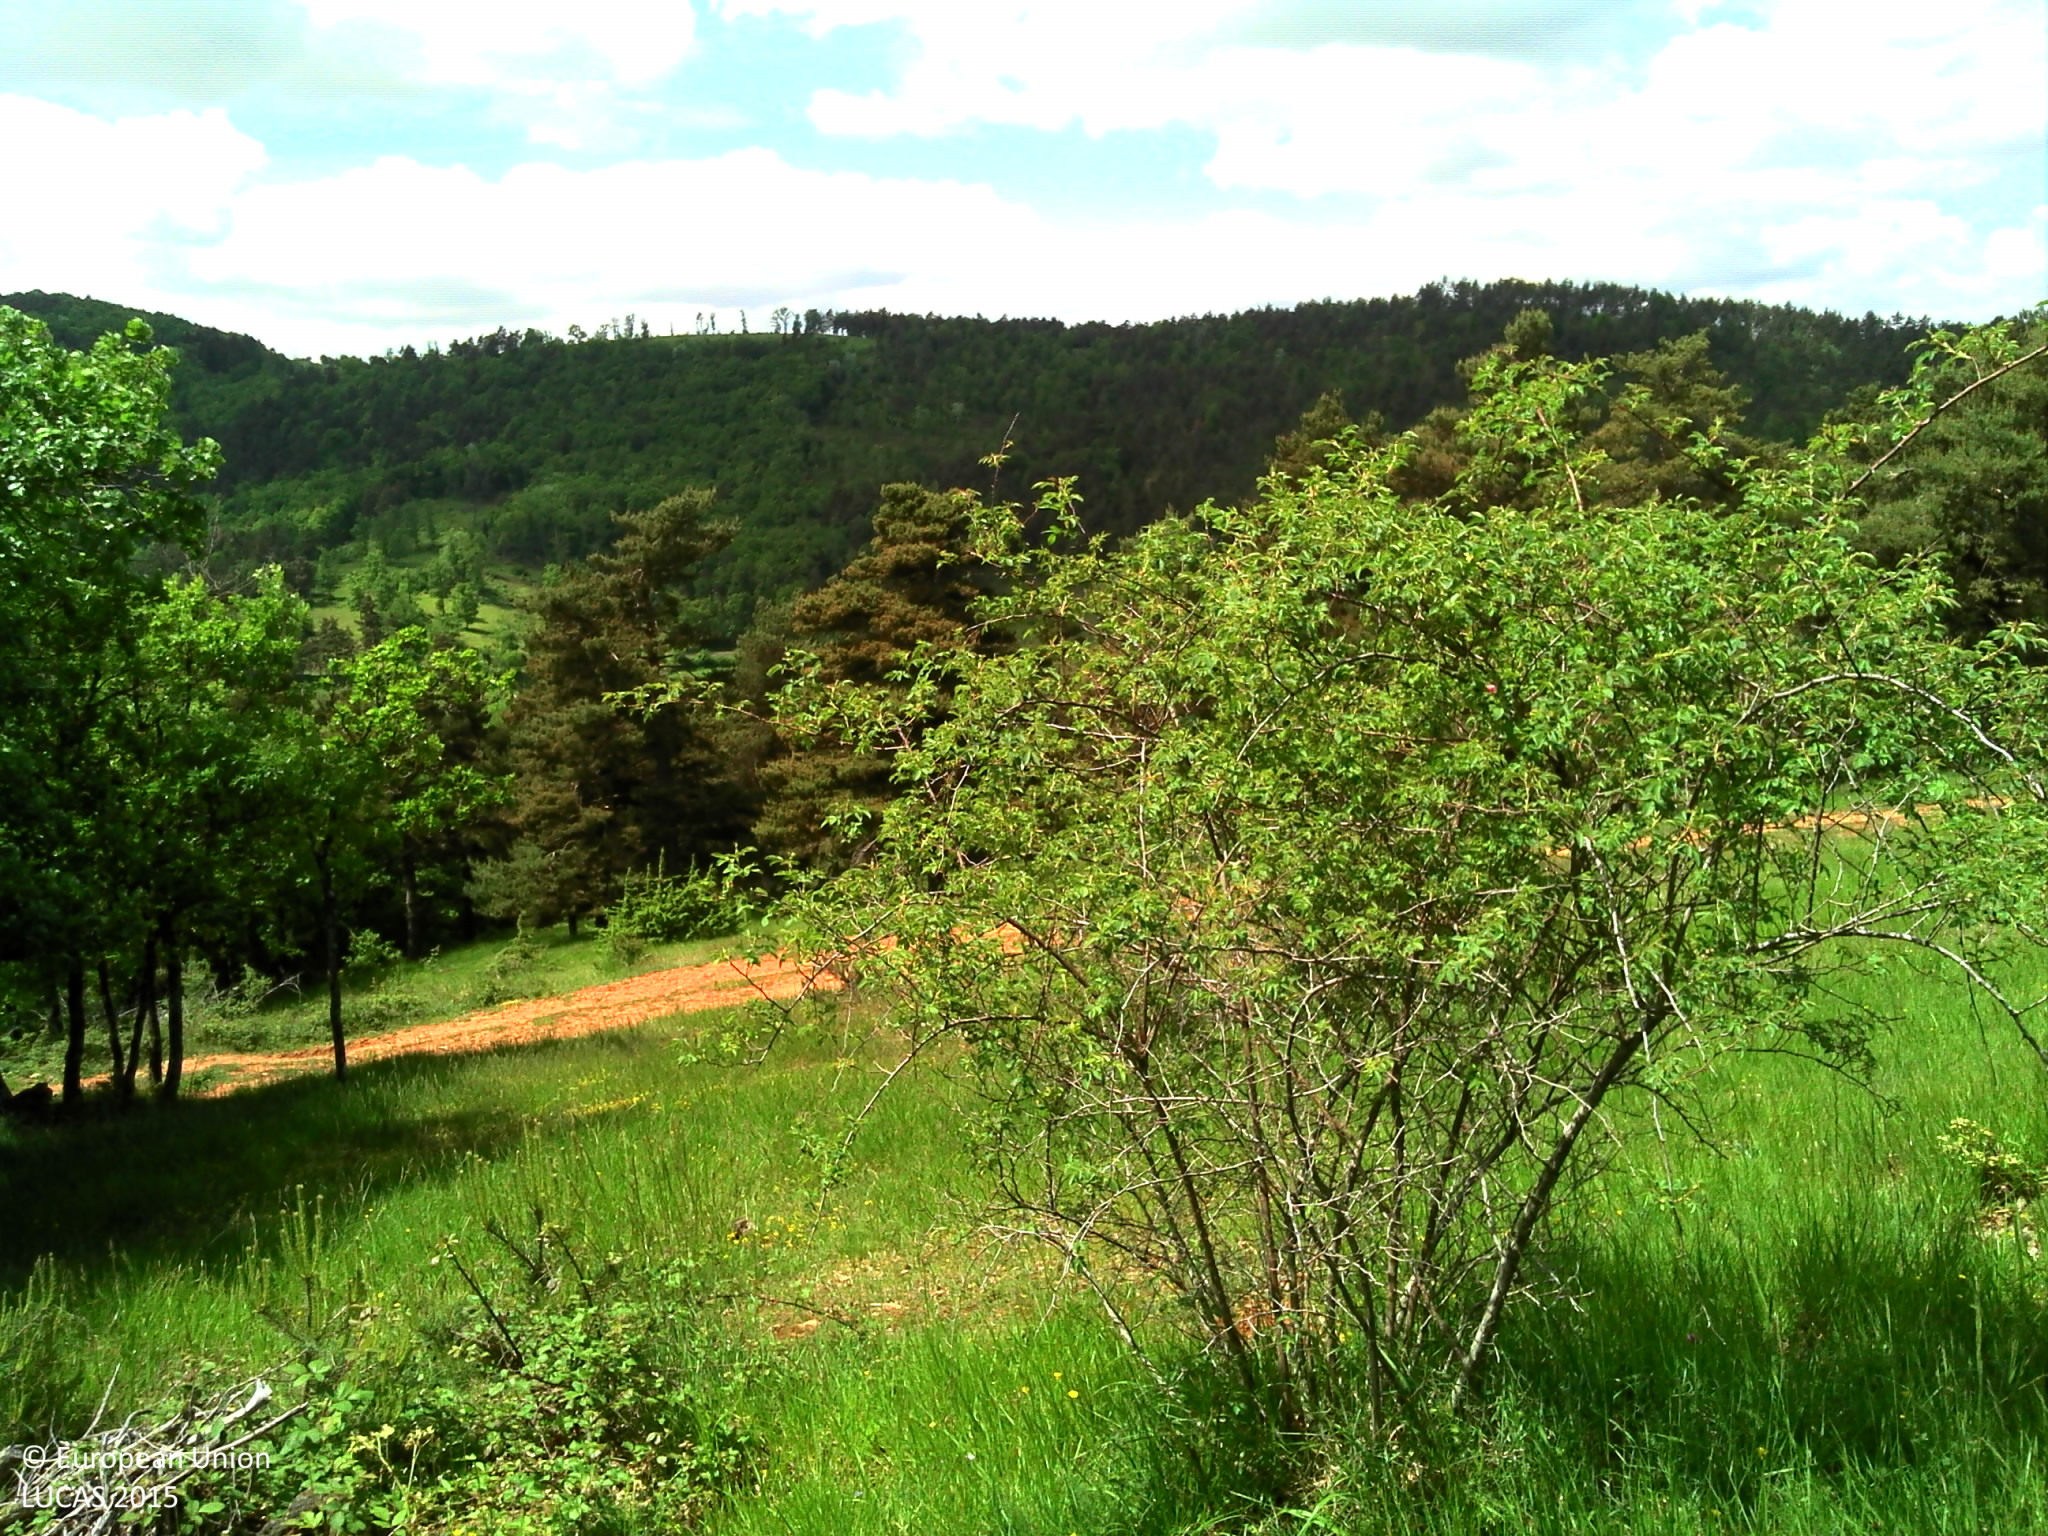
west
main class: Grassland
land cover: Grassland with sparse tree/shrub cover
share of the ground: > 75 %
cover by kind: herbaceous plants 90 %, broadleaved forest trees 5 %, shrubs 5 %
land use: Agriculture (excluding fallow land and kitchen gardens)
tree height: < 5 m
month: May
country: FR
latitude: 44.3880
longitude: 3.0377
